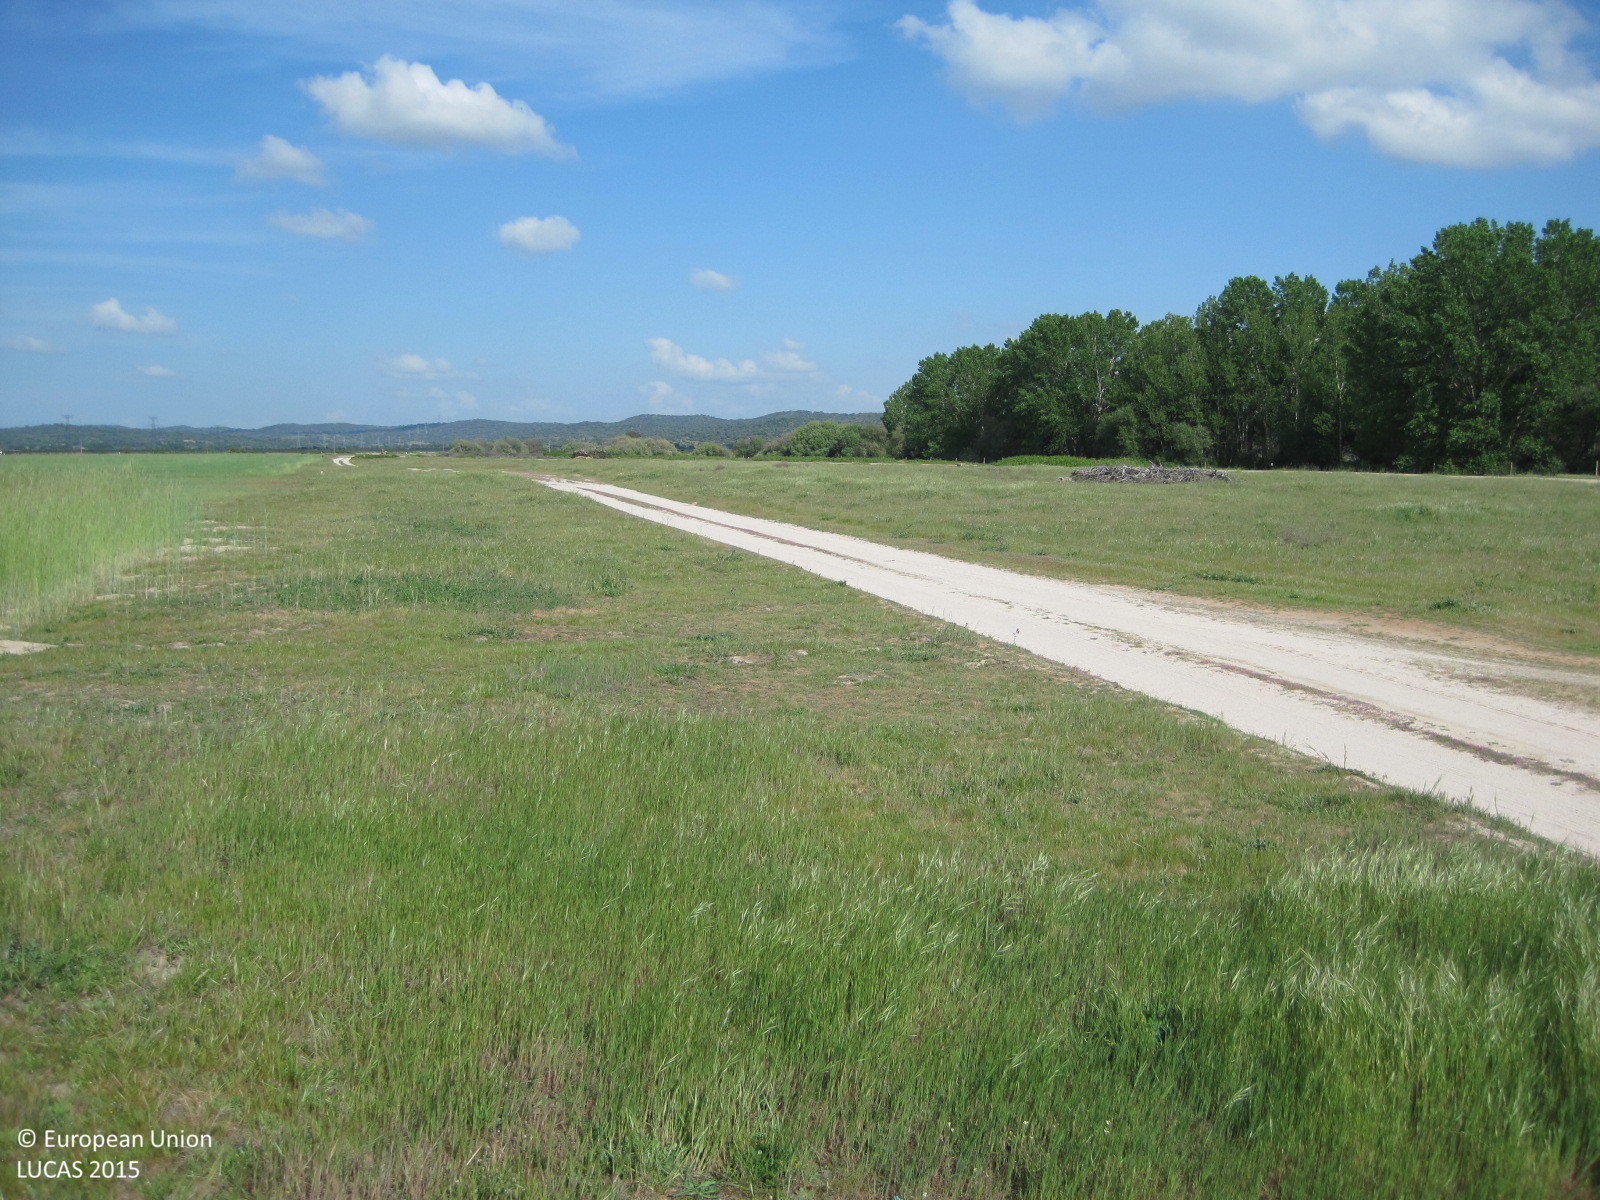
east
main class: Grassland
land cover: Grassland without tree/shrub cover
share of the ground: > 75 %
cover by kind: herbaceous plants 100 %
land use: Agriculture (excluding fallow land and kitchen gardens)
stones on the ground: 10 - 25 %
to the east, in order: Grassland without tree/shrub cover; Tracks; Grass margins; Grassland without tree/shrub cover; Tracks
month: April
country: ES
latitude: 40.0087
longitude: -4.9873
